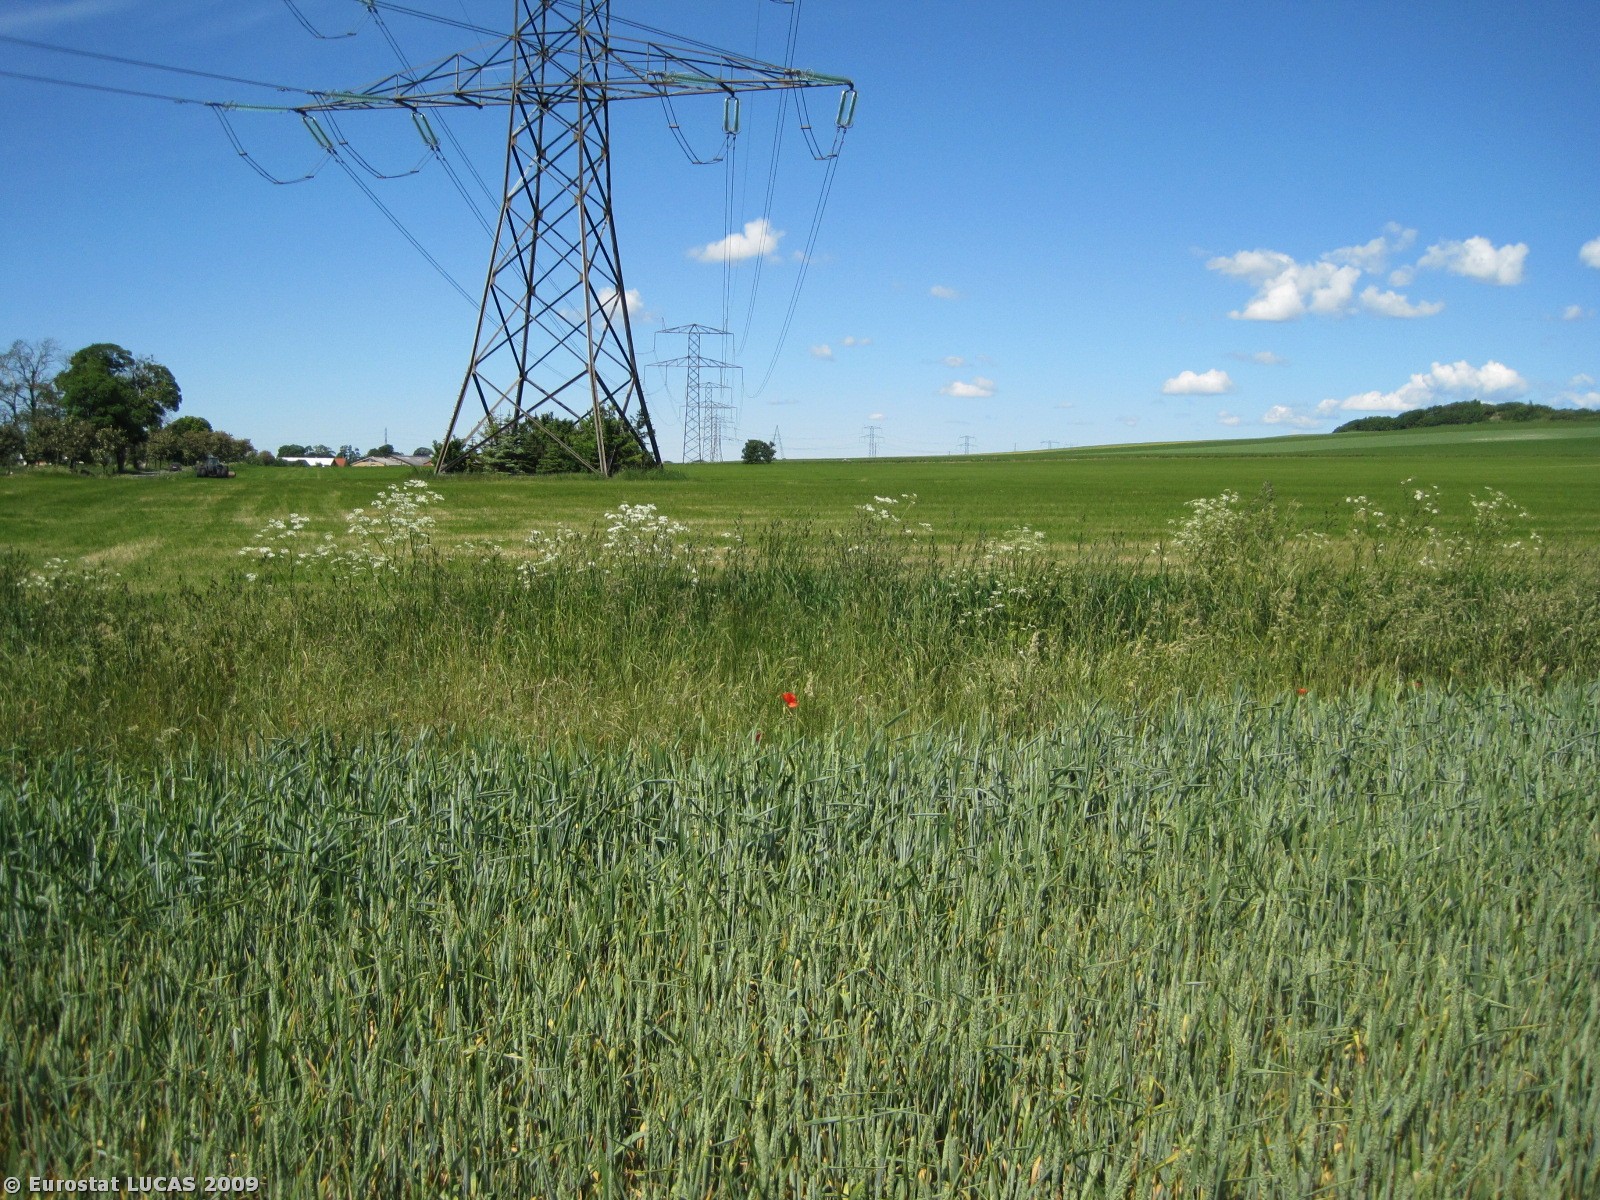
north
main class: Cropland
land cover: Common wheat
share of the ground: > 75 %
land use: Agriculture (excluding fallow land and kitchen gardens)
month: June
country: DK
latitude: 56.9607
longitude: 9.8851
